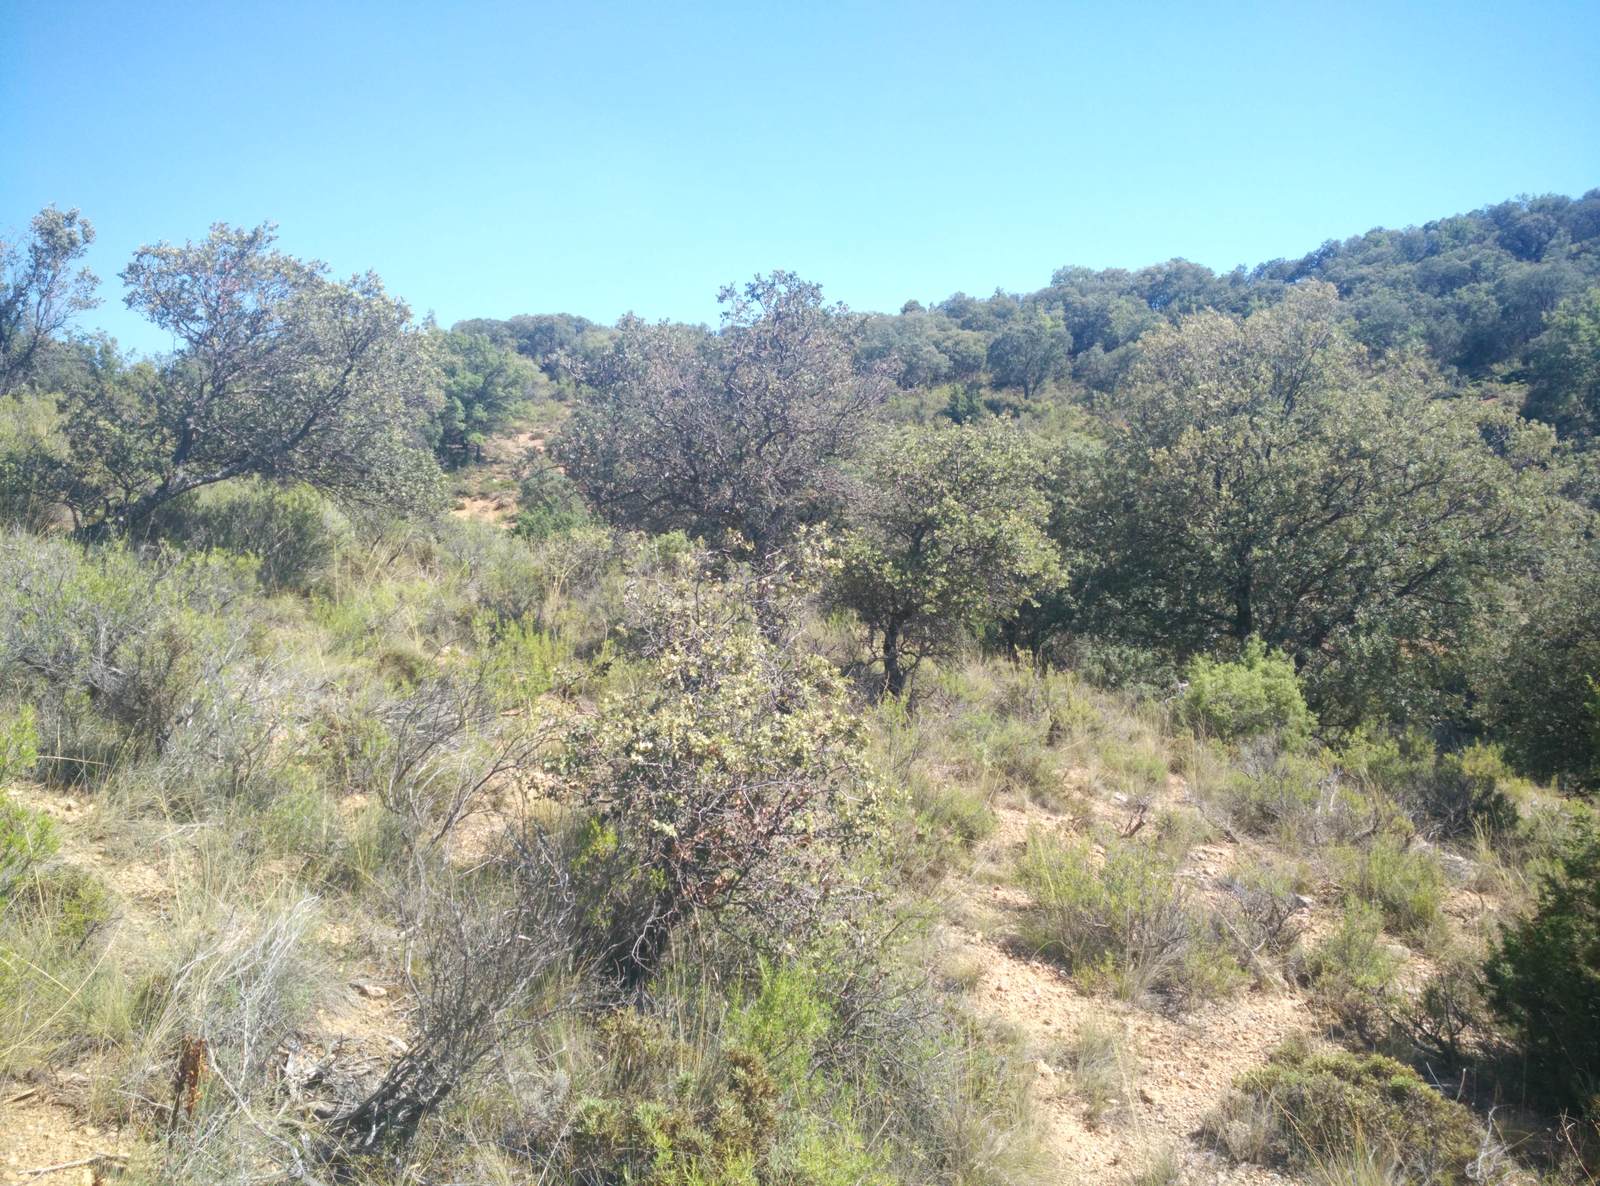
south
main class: Shrubland
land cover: Shrubland with sparse tree cover
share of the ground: > 75 %
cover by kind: shrubs 70 %, unconsolidated bare surface 15 %, herbaceous plants 10 %, broadleaved forest trees 5 %
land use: Semi-natural and natural areas not in use
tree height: > 5 m
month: July
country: ES
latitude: 40.7204
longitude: -2.6843
